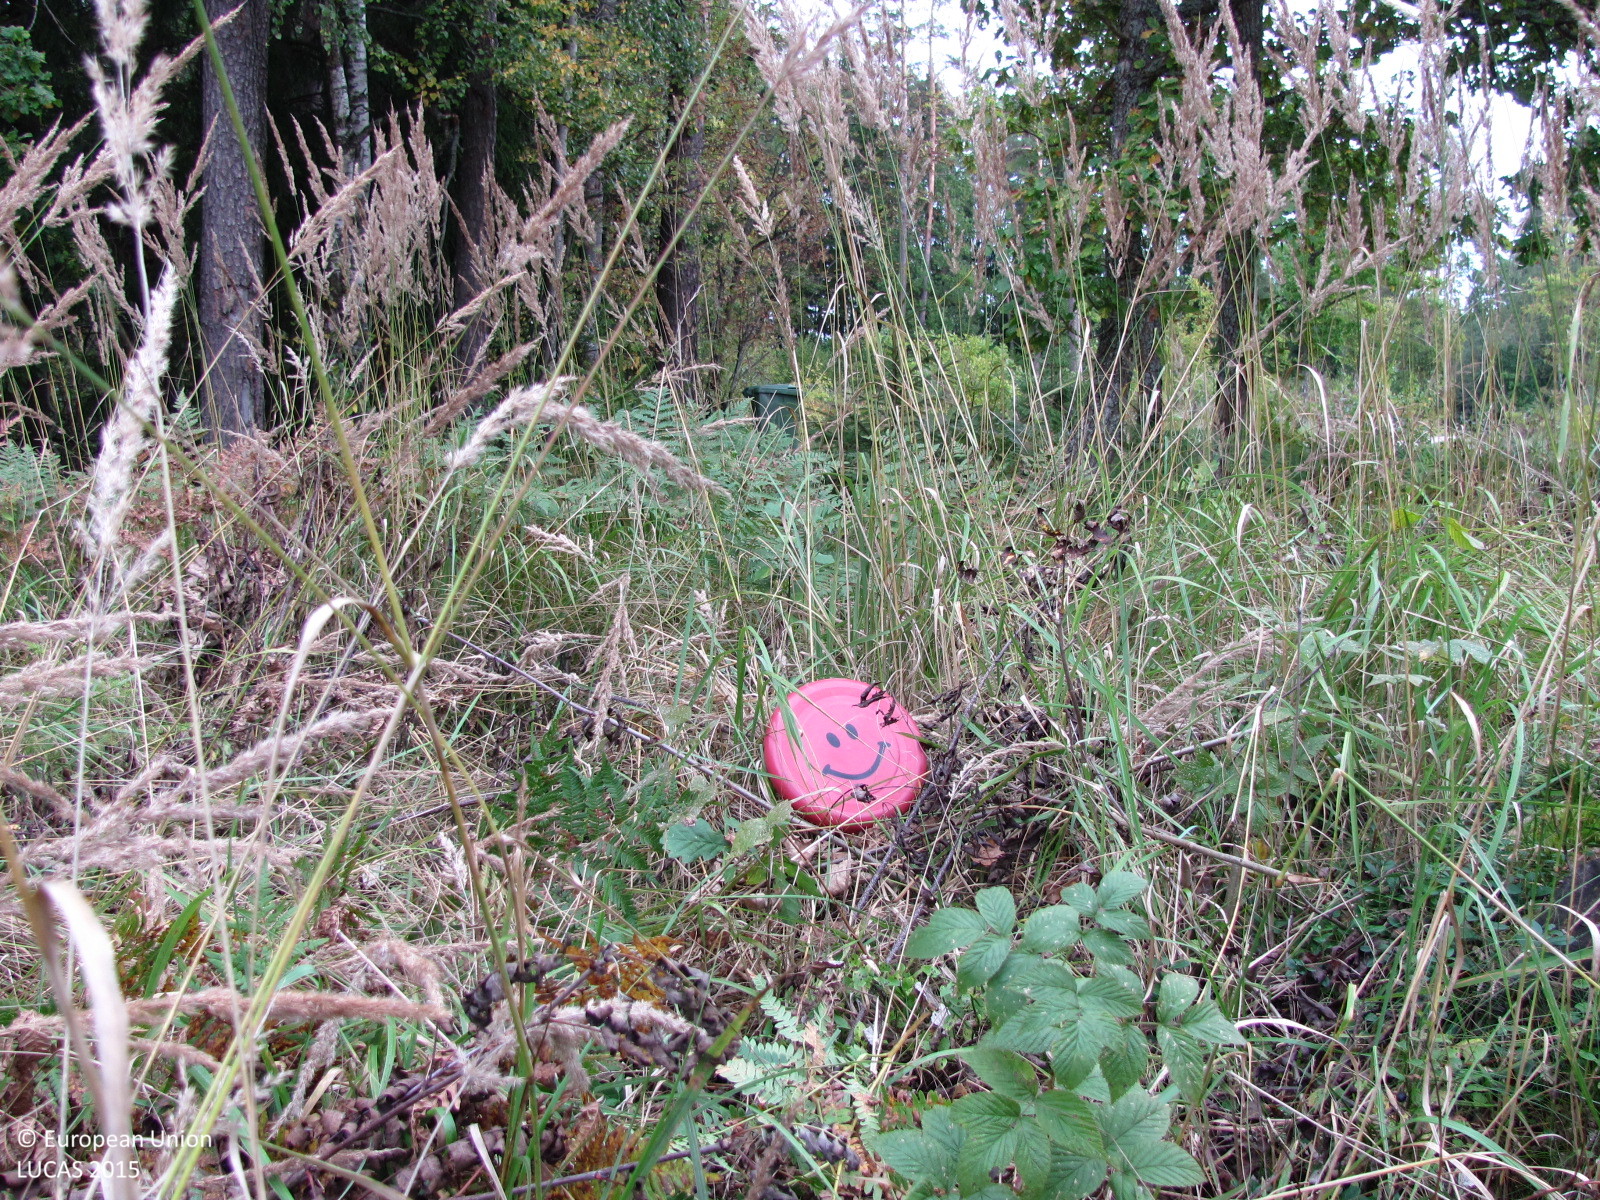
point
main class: Grassland
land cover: Grassland with sparse tree/shrub cover
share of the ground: > 75 %
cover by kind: herbaceous plants 95 %, broadleaved forest trees 5 %
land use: Semi-natural and natural areas not in use
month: September
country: LV
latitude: 57.1351
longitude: 24.6529
